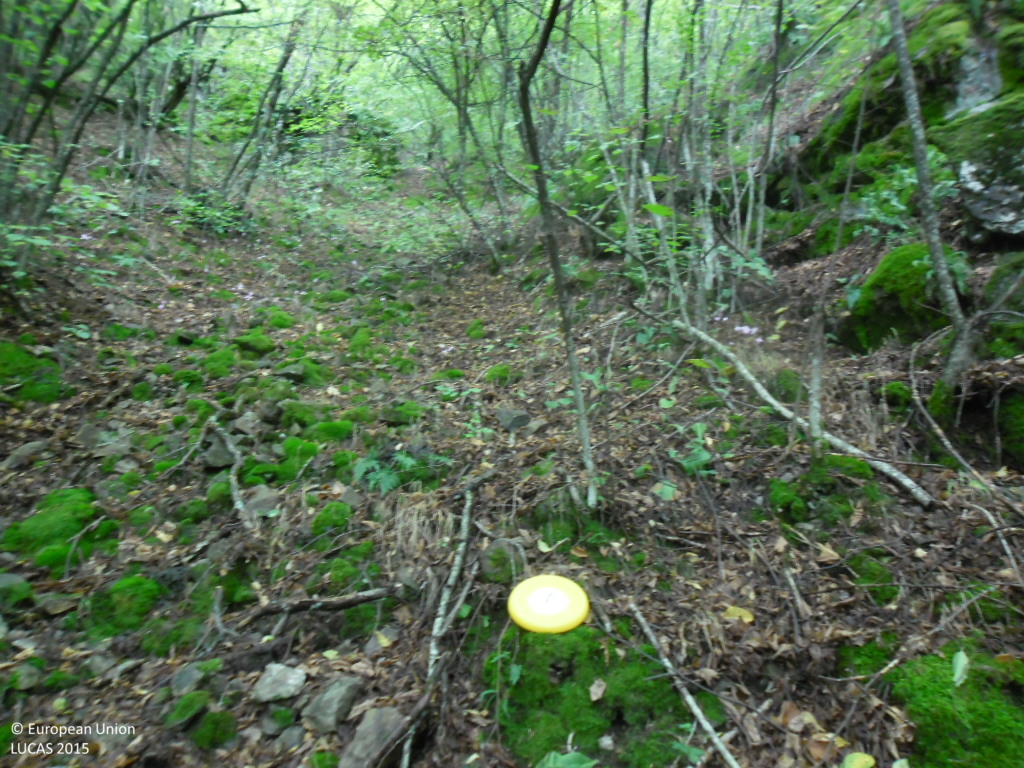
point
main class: Woodland
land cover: Broadleaved woodland
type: mesophytic deciduous forest
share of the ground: > 75 %
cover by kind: broadleaved forest trees 90 %, unconsolidated bare surface 10 %
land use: Forestry
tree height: > 5 m
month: September
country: BG
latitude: 41.3574
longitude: 22.9851
